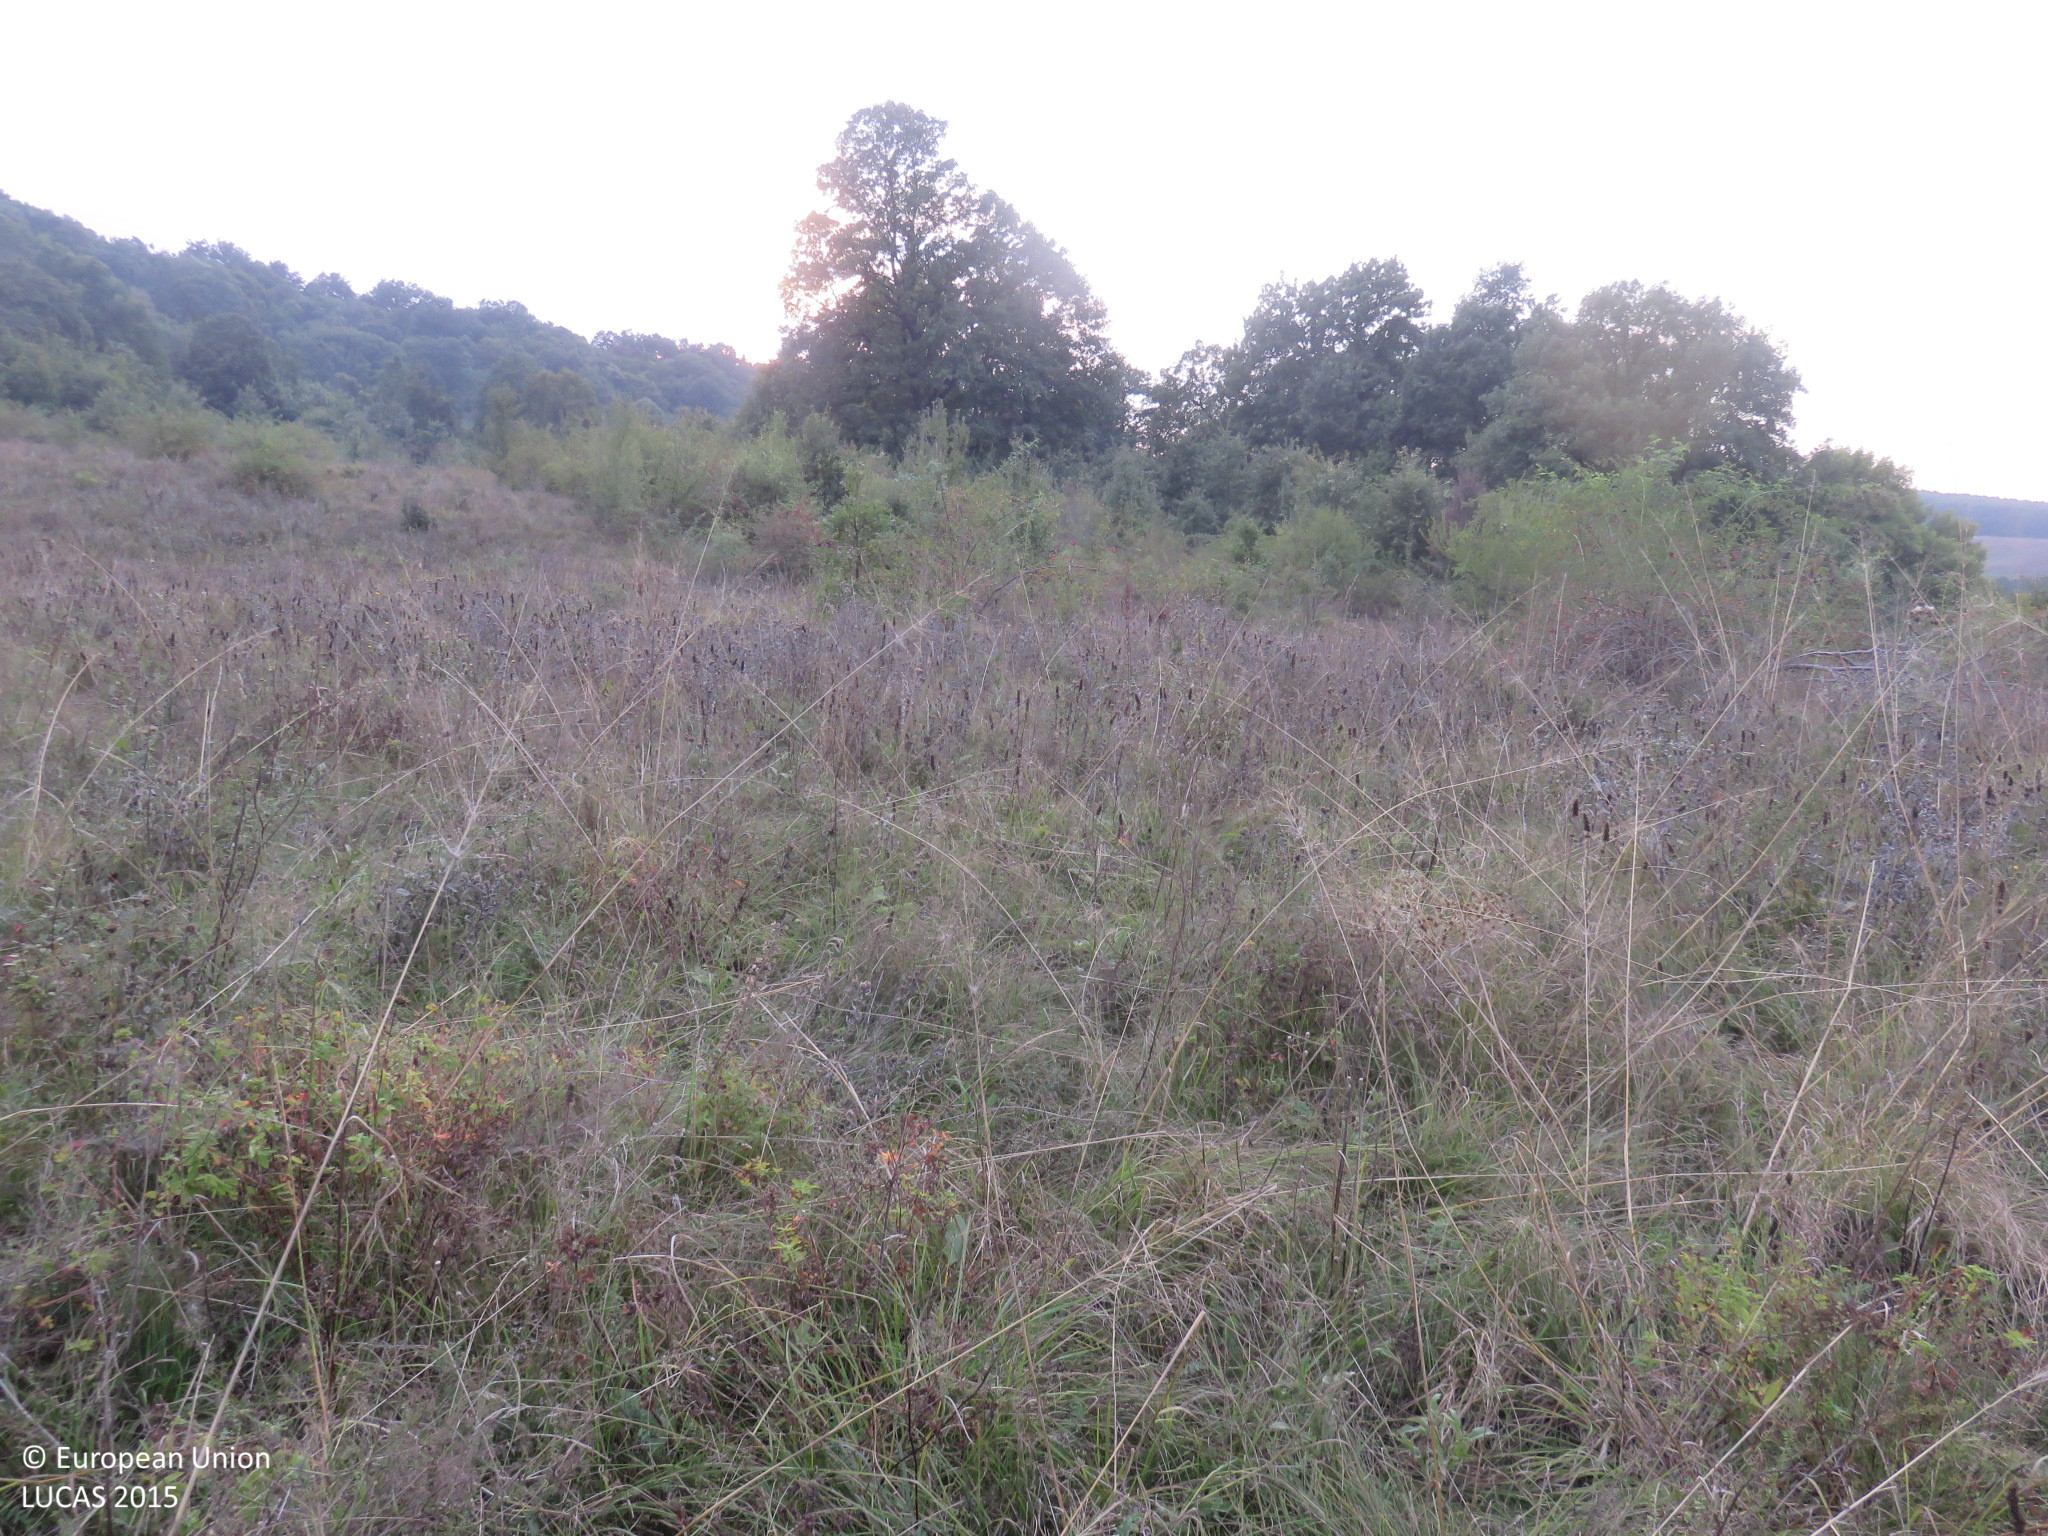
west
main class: Grassland
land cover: Grassland with sparse tree/shrub cover
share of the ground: > 75 %
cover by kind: herbaceous plants 95 %, broadleaved forest trees 5 %
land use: Semi-natural and natural areas not in use
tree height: > 5 m
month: September
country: BG
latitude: 43.1175
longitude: 24.9245
